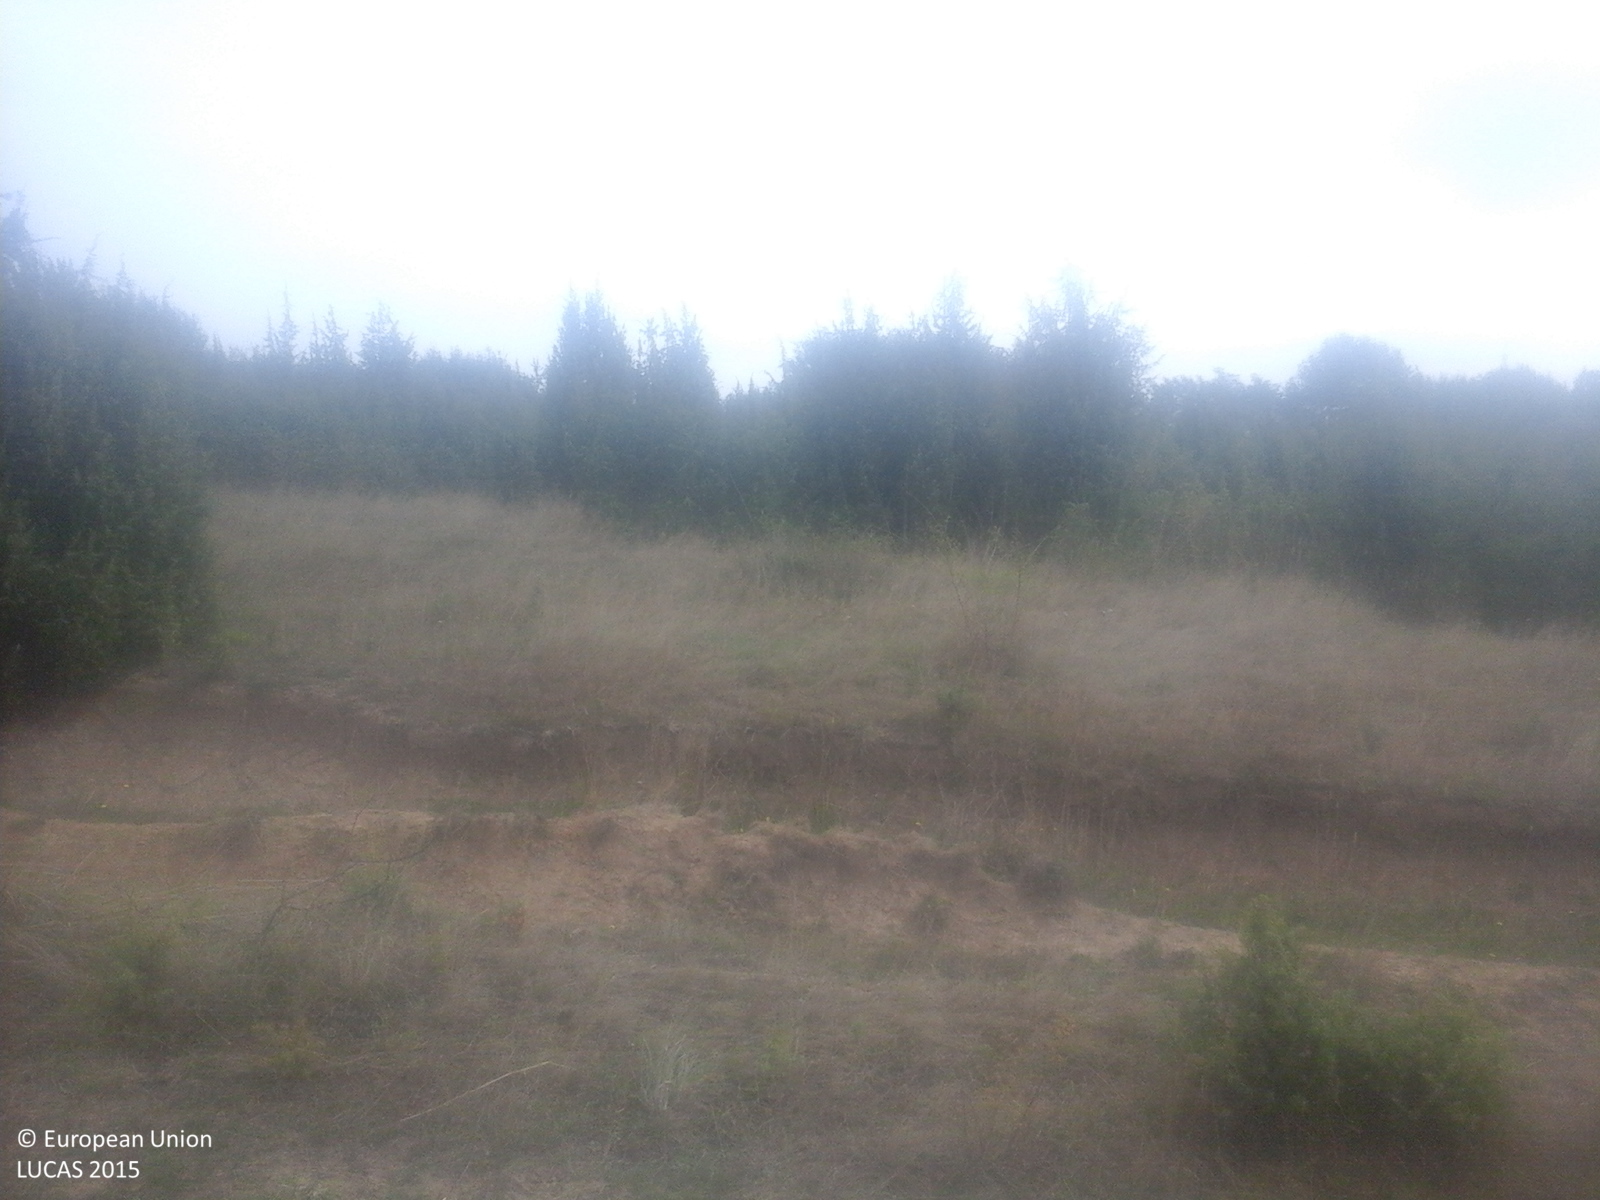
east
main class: Shrubland
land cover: Shrubland with sparse tree cover
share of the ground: > 75 %
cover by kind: shrubs 60 %, herbaceous plants 35 %, coniferous forest trees 5 %
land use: Forestry
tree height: < 5 m
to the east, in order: Shrubland with sparse tree cover; Tracks; Shrubland with sparse tree cover; Tracks; Shrubland with sparse tree cover; Ditches and canals; Shrubland with sparse tree cover; Tracks; Grassland without tree/shrub cover; Tracks; Grassland with sparse tree/shrub cover; Broadleaved woodland; Permanent crops (only in case pi)
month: September
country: RO
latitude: 45.4254
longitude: 21.9361
